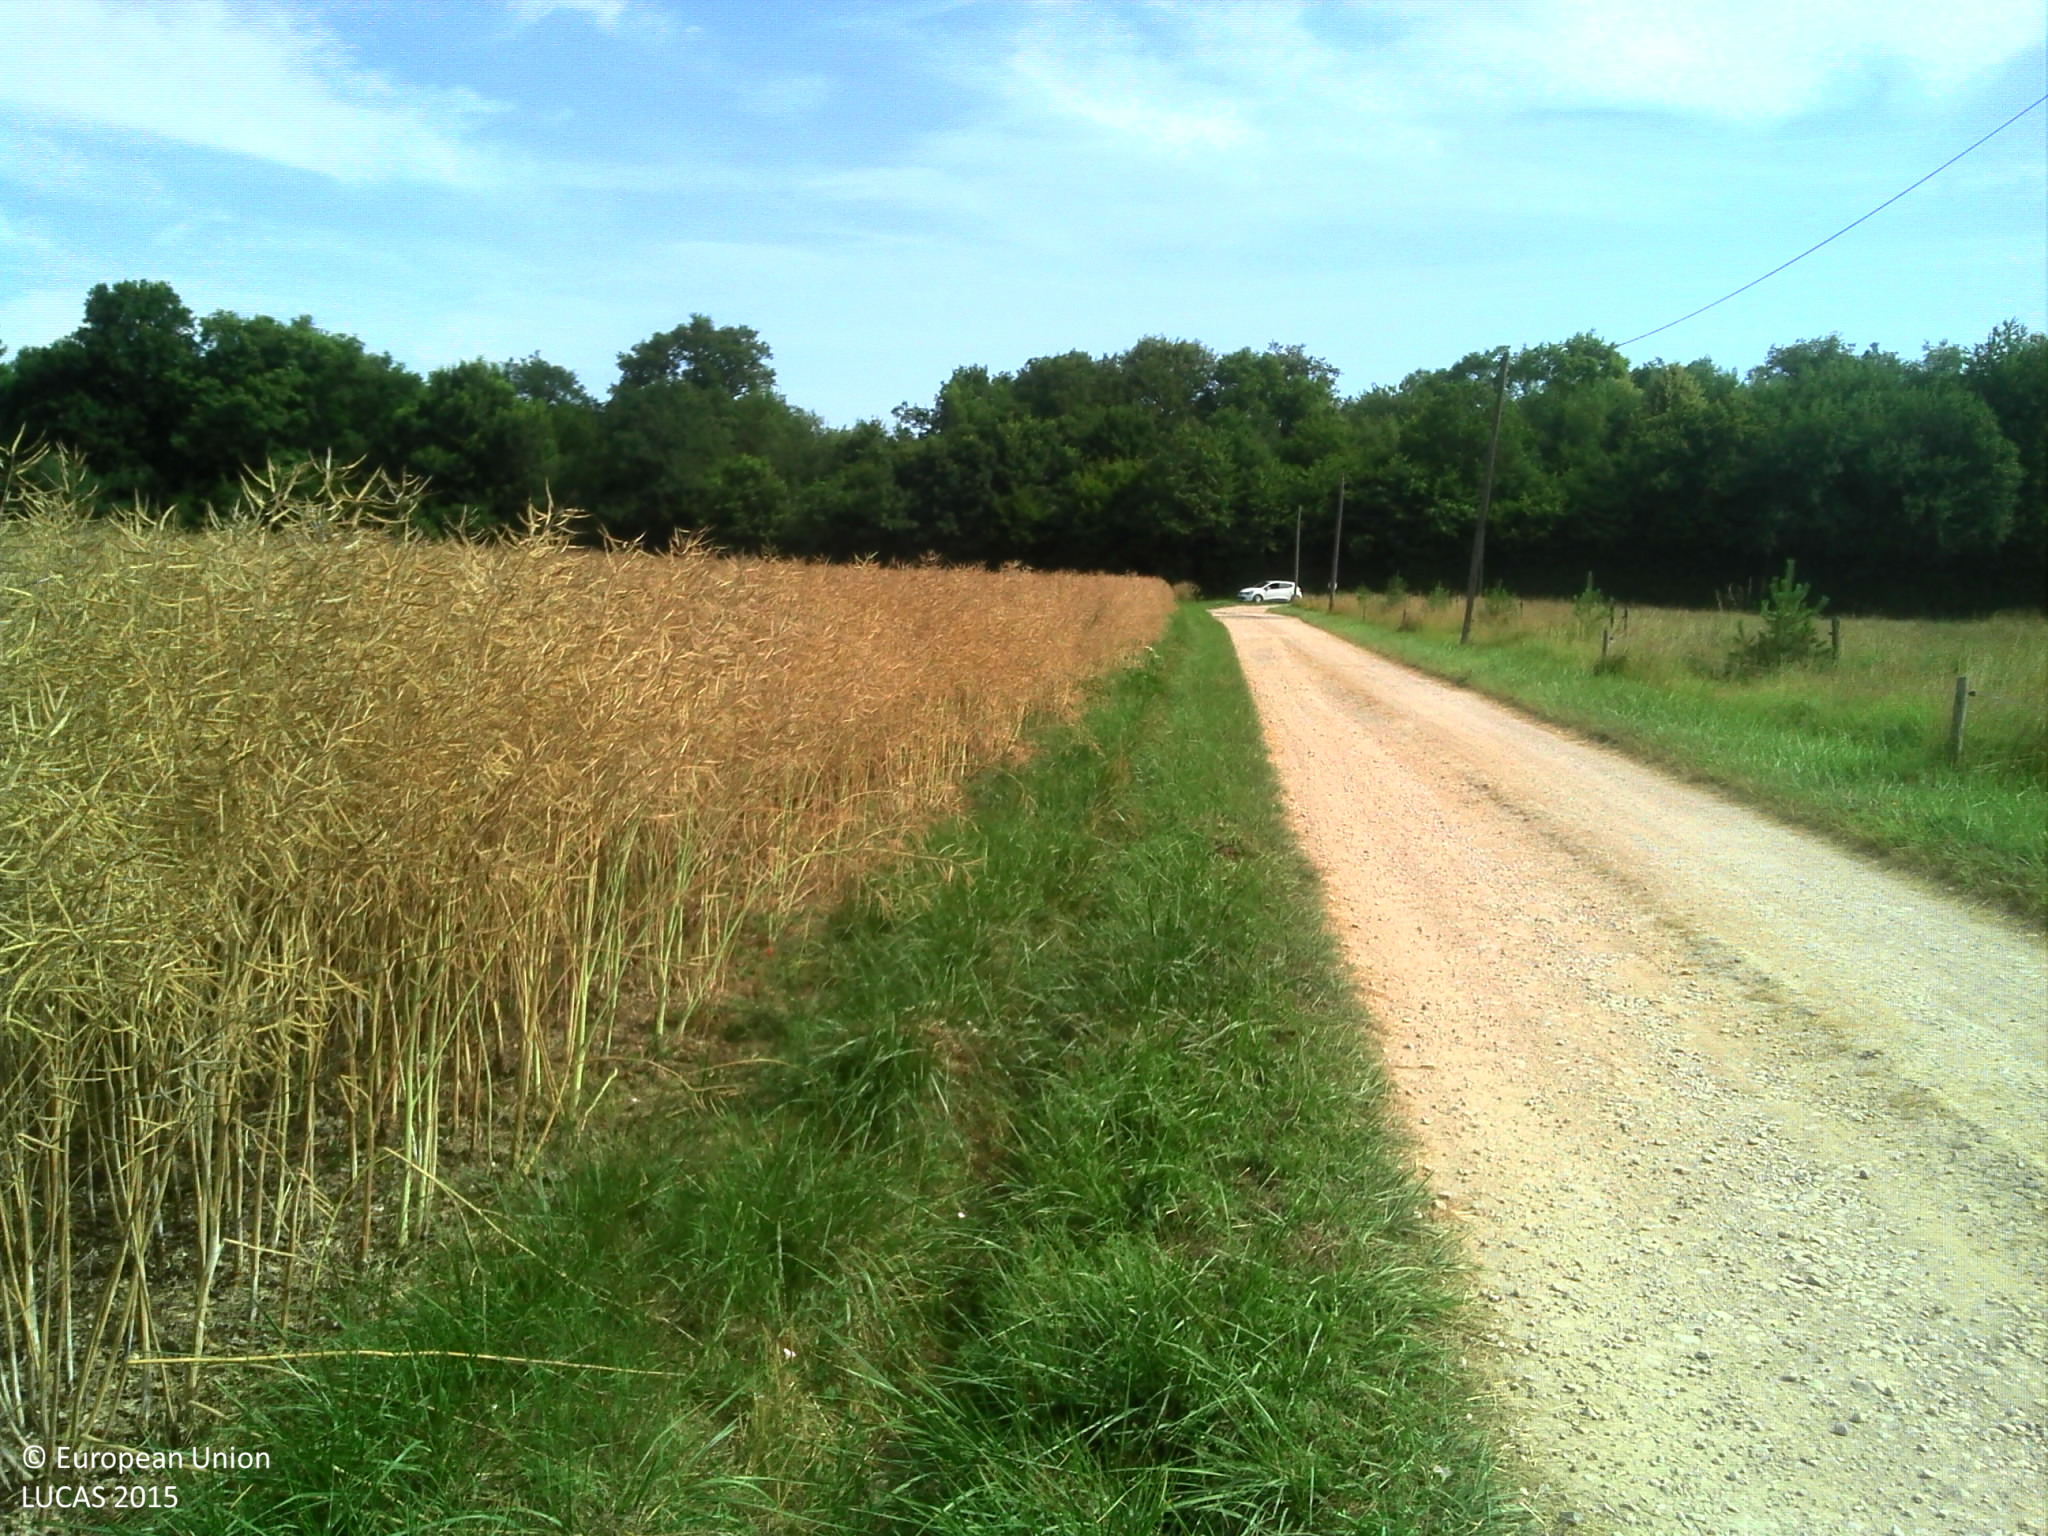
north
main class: Cropland
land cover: Rape and turnip rape
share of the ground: > 75 %
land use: Agriculture (excluding fallow land and kitchen gardens)
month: June
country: FR
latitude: 46.7111
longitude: 4.7820
